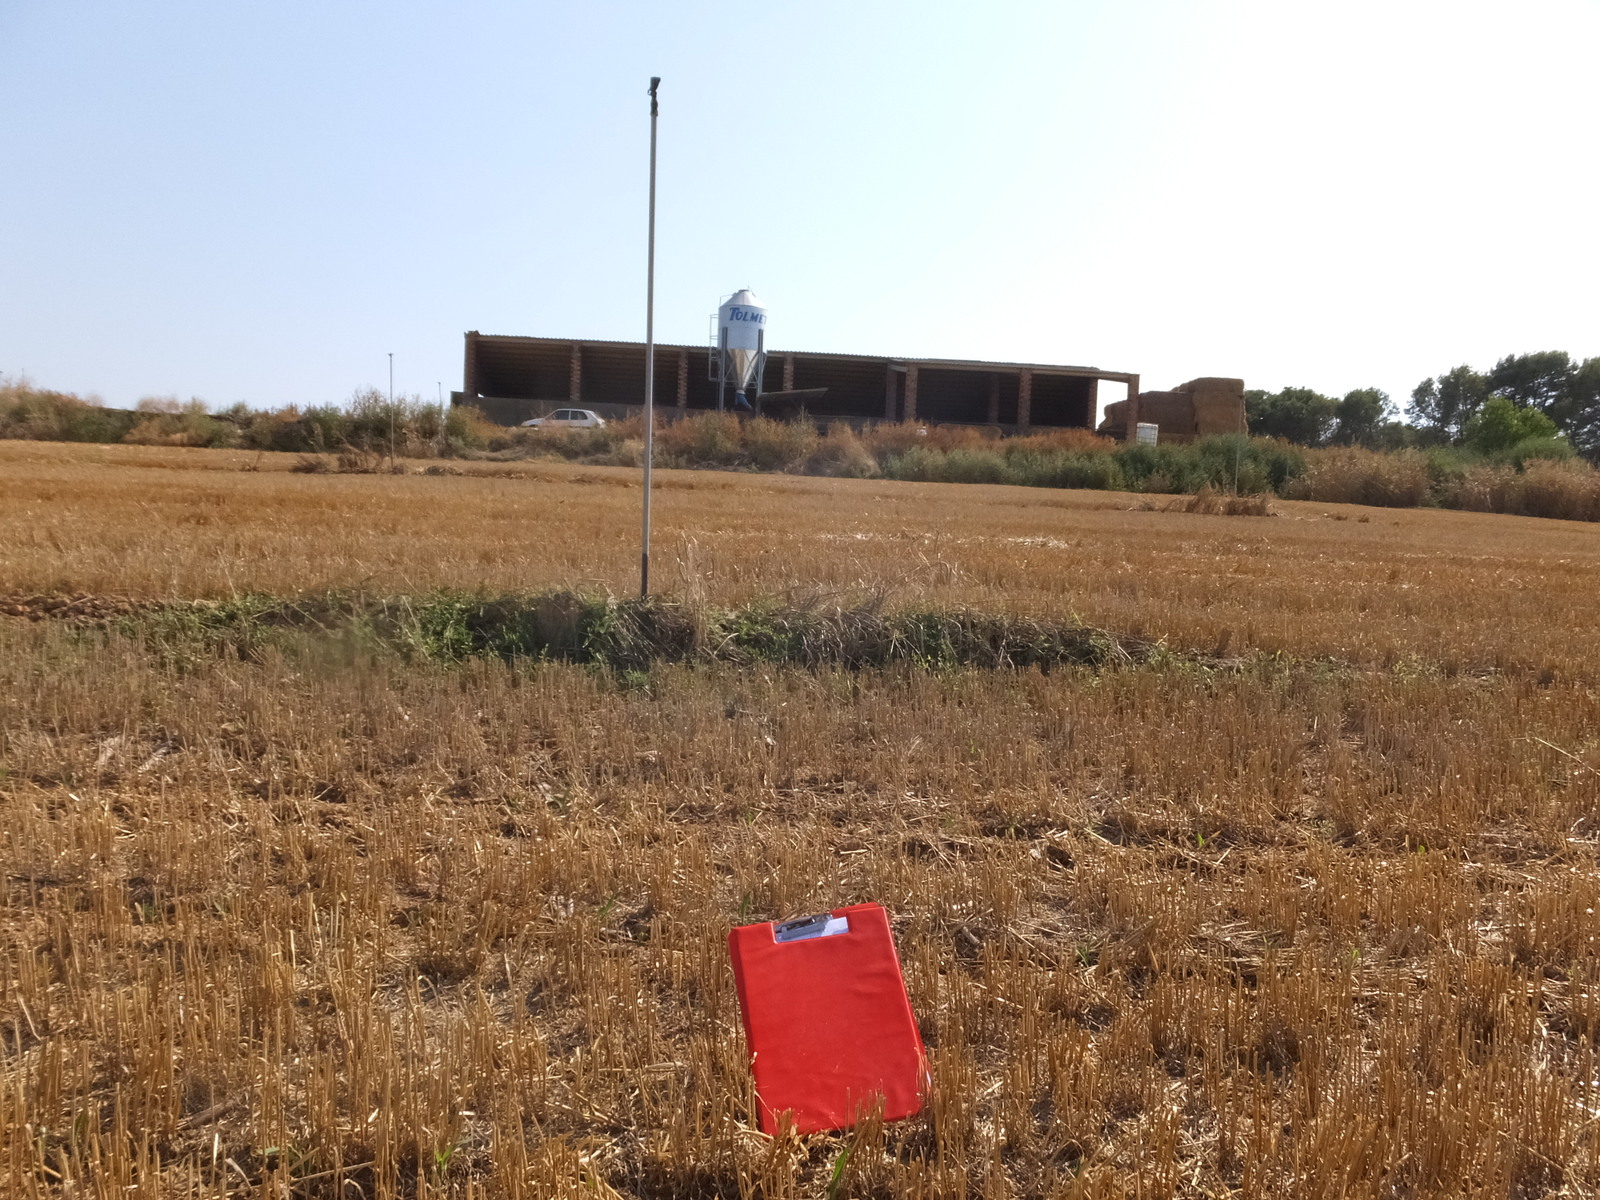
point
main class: Cropland
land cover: Maize
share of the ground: < 10 %
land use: Agriculture (excluding fallow land and kitchen gardens)
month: July
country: ES
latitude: 41.7001
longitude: 0.3363
